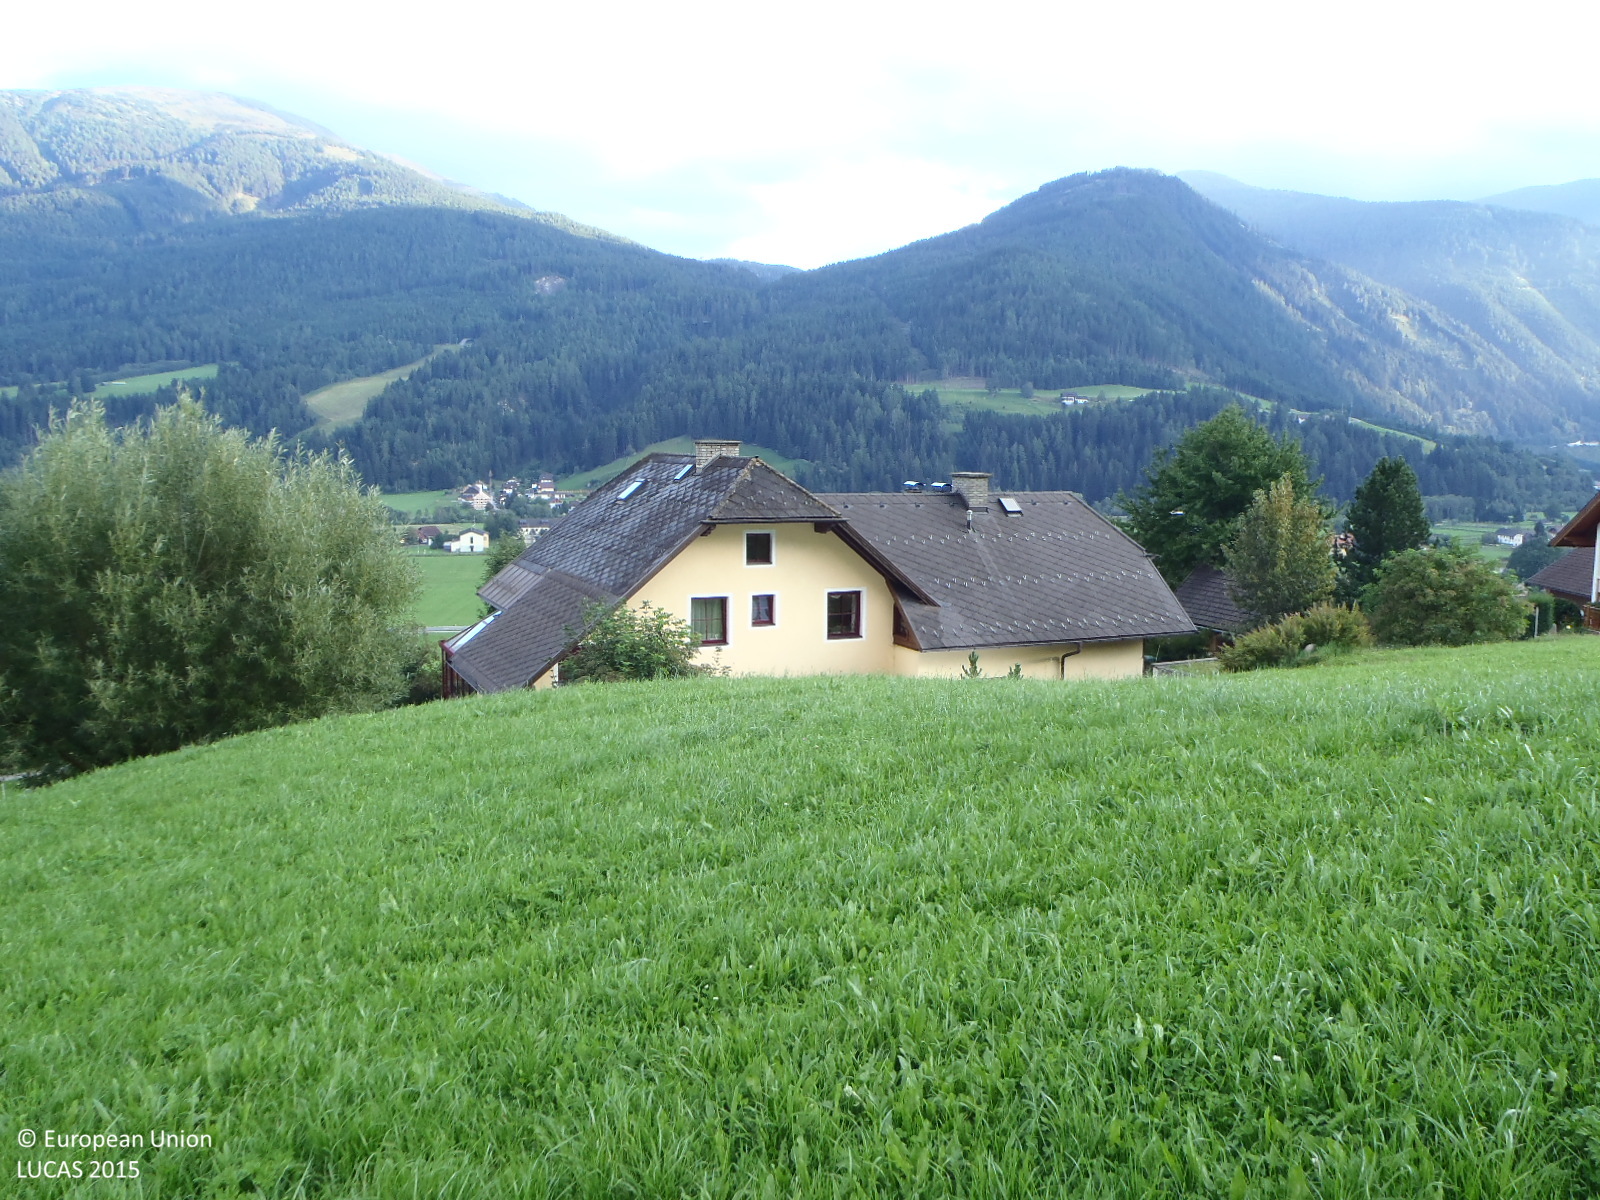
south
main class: Grassland
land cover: Grassland without tree/shrub cover
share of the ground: > 75 %
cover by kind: herbaceous plants 100 %
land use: Agriculture (excluding fallow land and kitchen gardens)
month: August
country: AT
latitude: 47.1011
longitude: 13.6213
